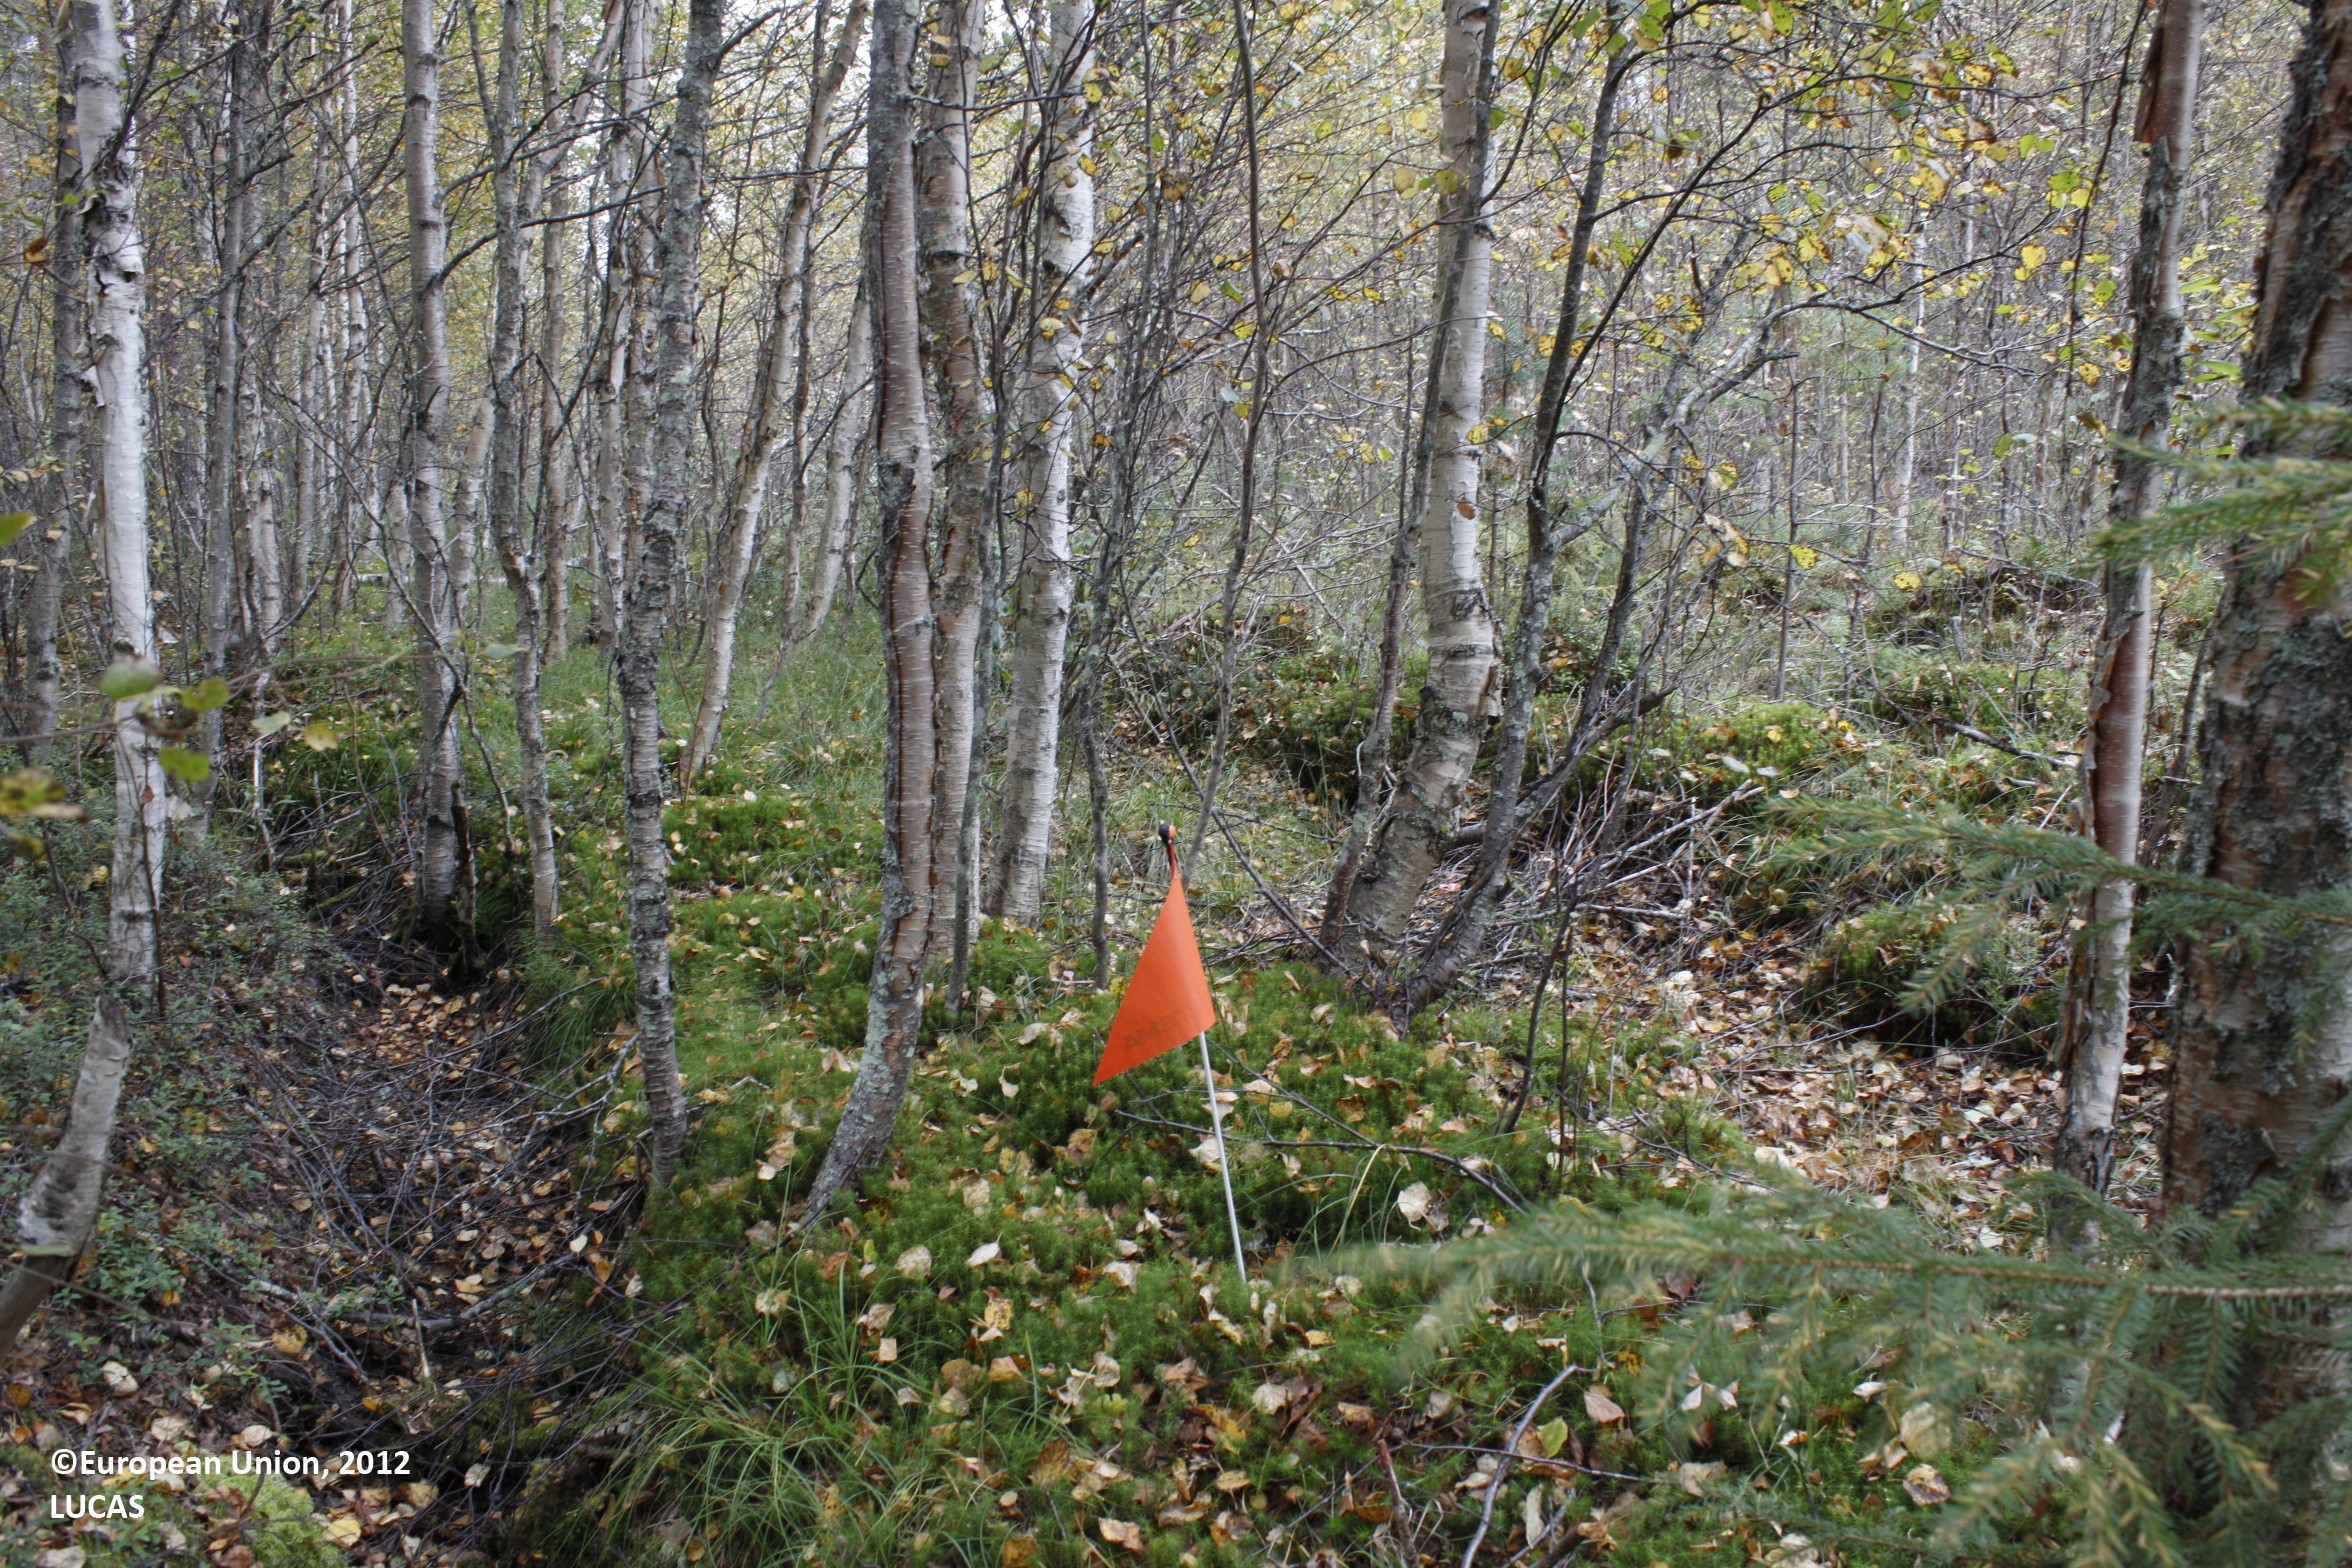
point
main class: Woodland
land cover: Pine dominated mixed woodland
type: boreal forest
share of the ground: > 75 %
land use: Forestry
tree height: > 5 m
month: September
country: FI
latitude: 65.3841
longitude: 27.0066
